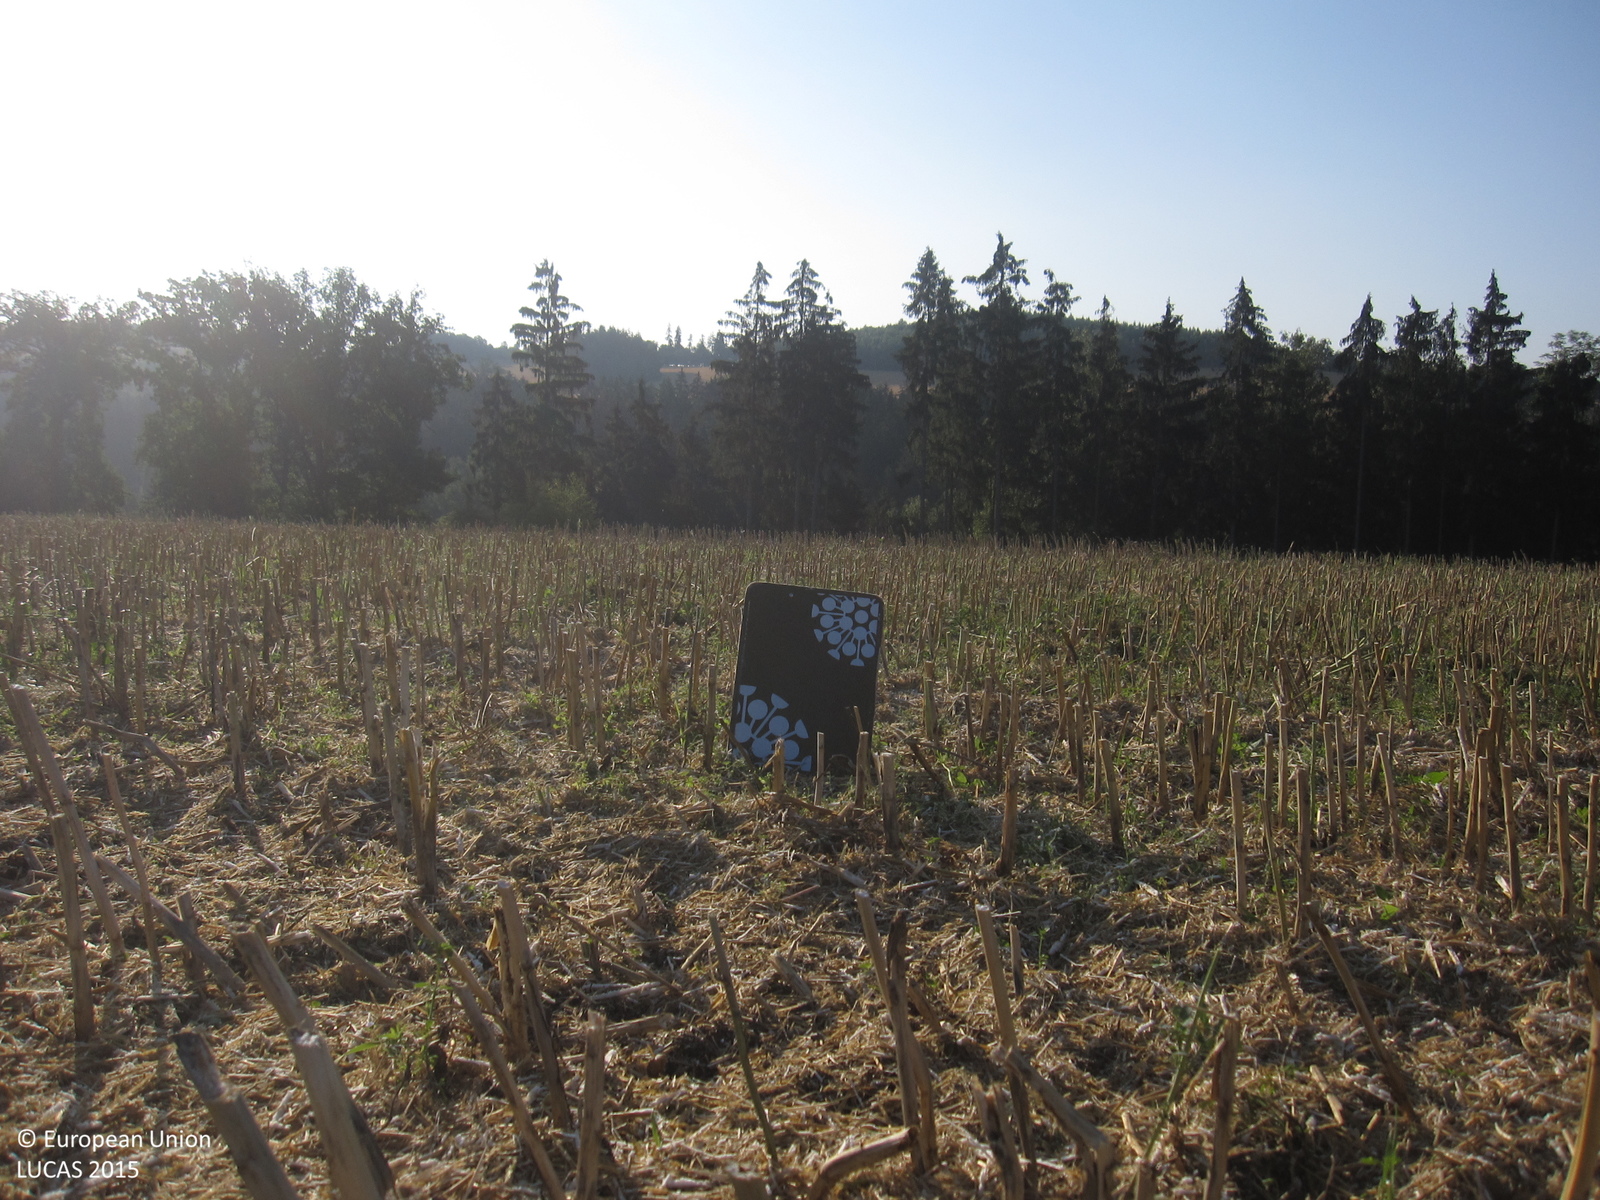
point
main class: Cropland
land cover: Rape and turnip rape
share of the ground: < 10 %
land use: Agriculture (excluding fallow land and kitchen gardens)
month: July
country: DE
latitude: 50.4178
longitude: 12.0403
